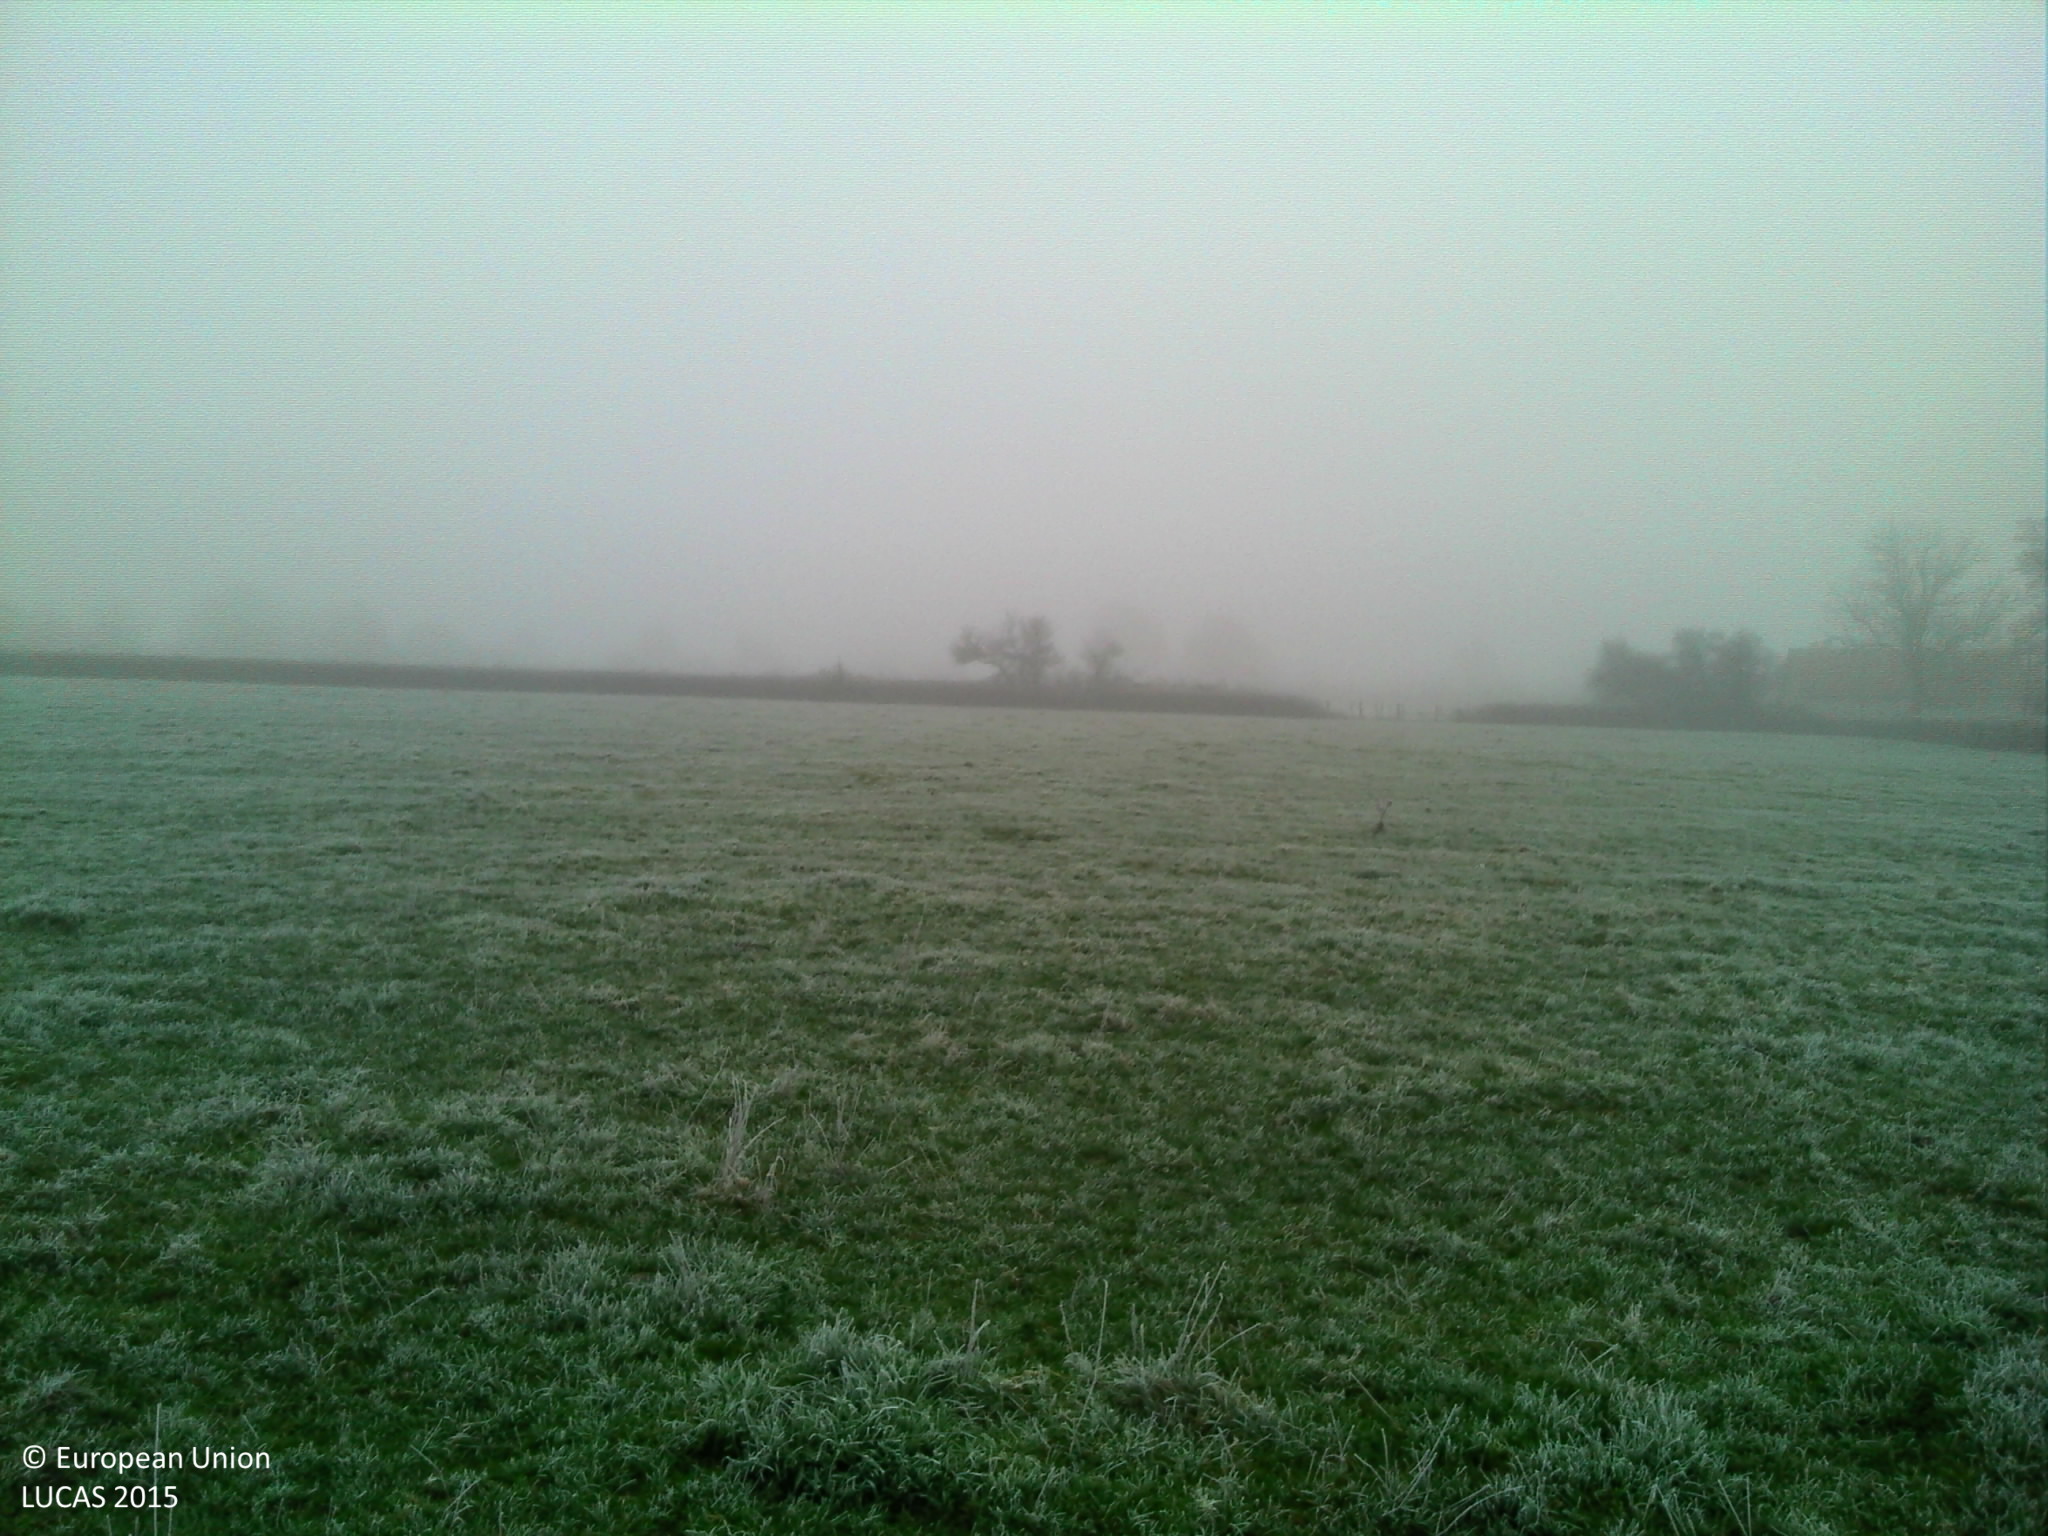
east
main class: Grassland
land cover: Grassland without tree/shrub cover
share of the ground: > 75 %
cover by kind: herbaceous plants 100 %
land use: Agriculture (excluding fallow land and kitchen gardens)
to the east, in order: Grassland without tree/shrub cover; Fences; Managed hedges; Grassland without tree/shrub cover
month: November
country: FR
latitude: 46.6135
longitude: 3.6400
